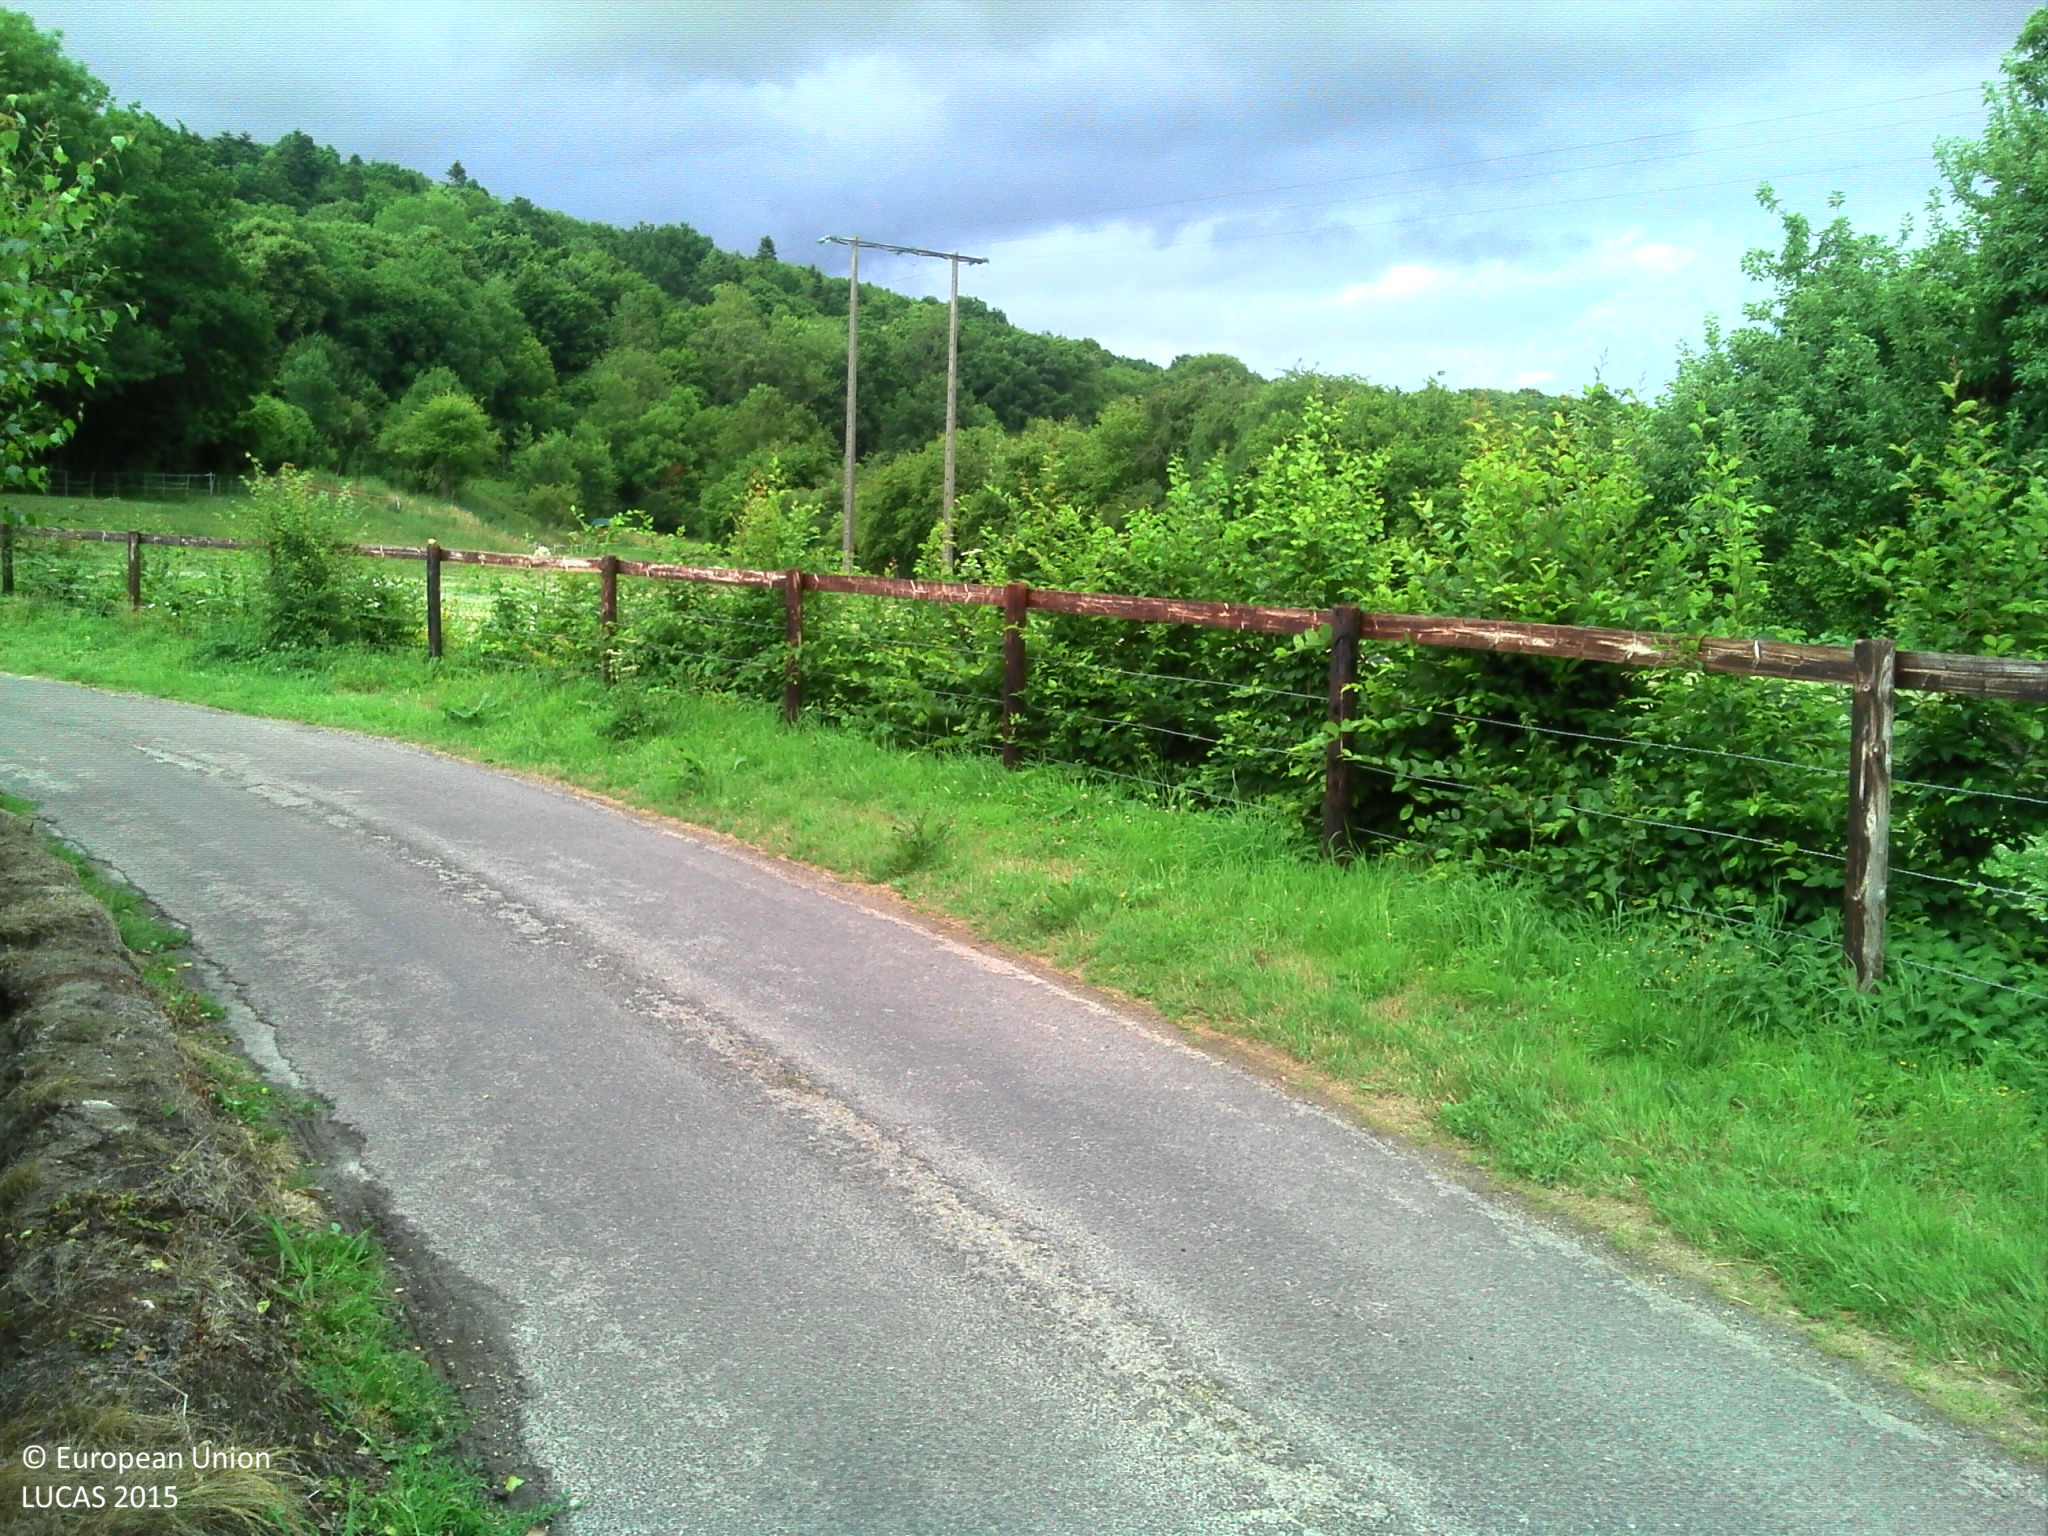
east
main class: Grassland
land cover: Grassland without tree/shrub cover
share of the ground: > 75 %
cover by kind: herbaceous plants 100 %
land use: Residential
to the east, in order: Grassland without tree/shrub cover; Artificial constructions in urban areas; Lines of trees; Fences; Grassland without tree/shrub cover; Fences; Grassland without tree/shrub cover; Fences; Spontaneously vegetated surfaces; Broadleaved woodland
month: July
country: FR
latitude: 49.2171
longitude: 0.4039
